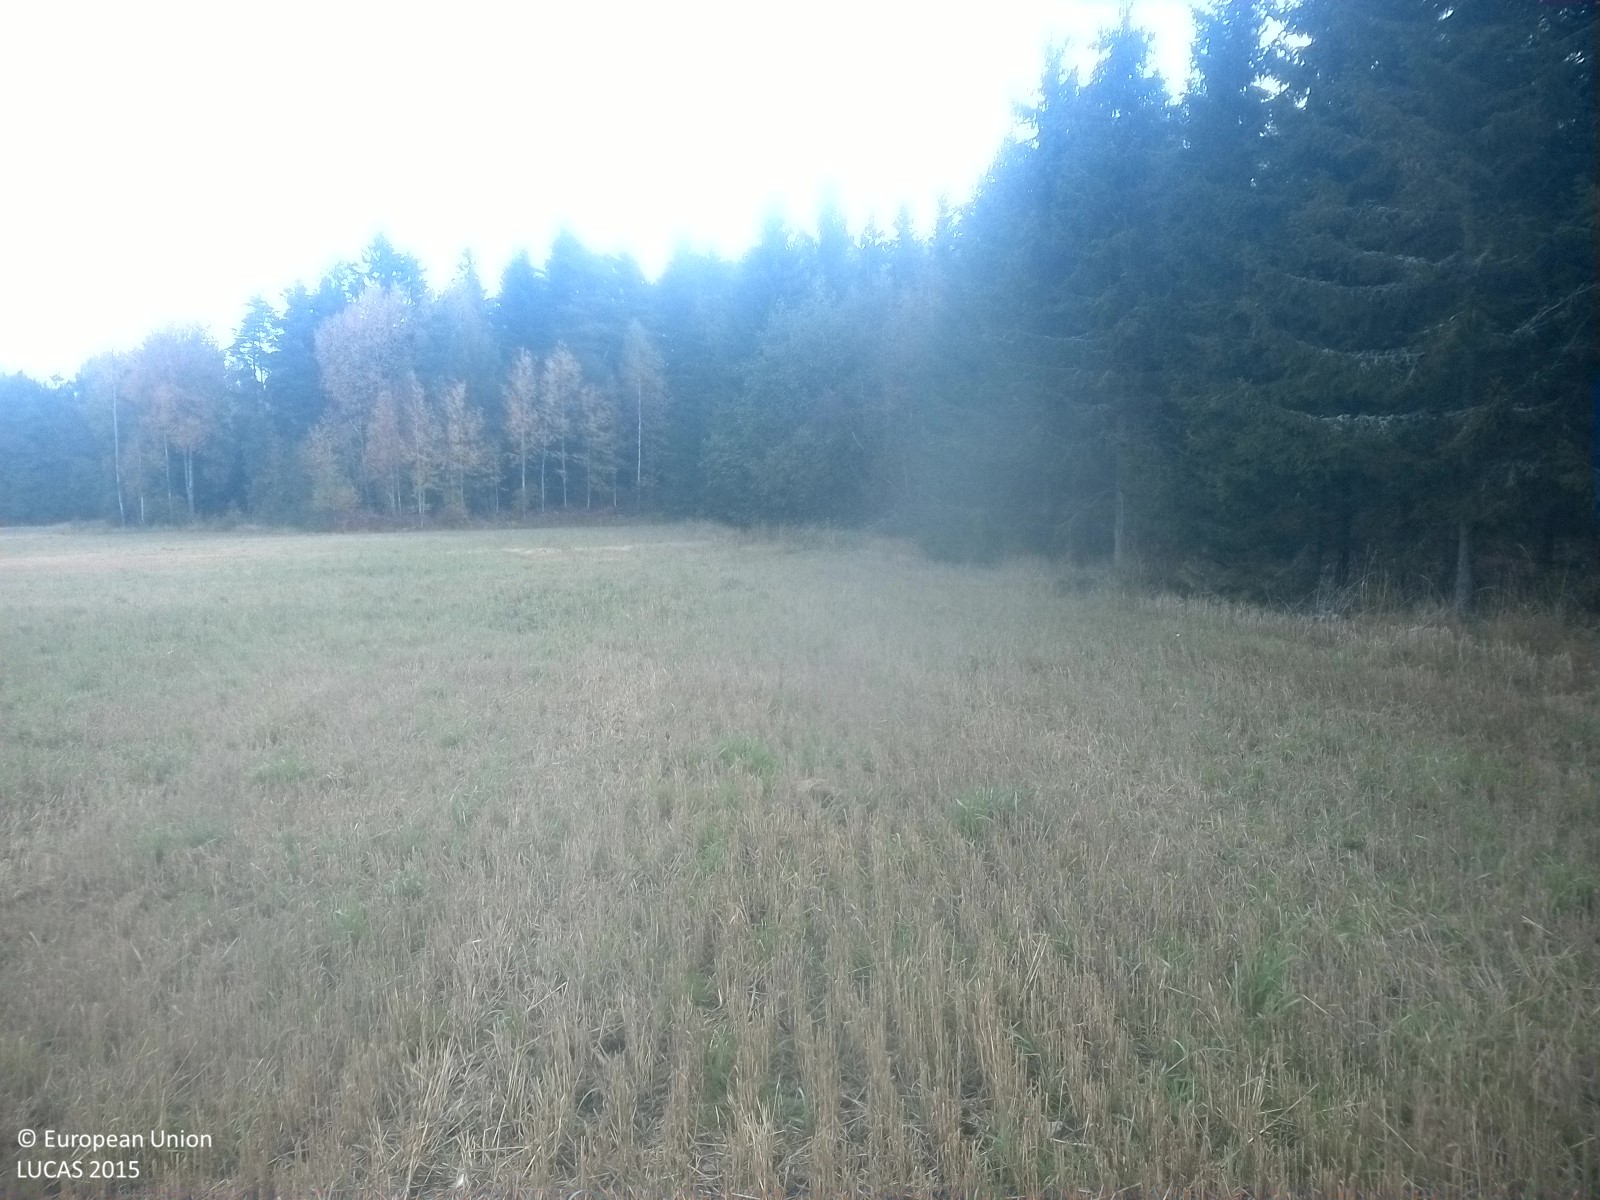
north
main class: Cropland
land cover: Barley
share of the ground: < 10 %
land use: Agriculture (excluding fallow land and kitchen gardens)
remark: Harvested field
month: September
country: SE
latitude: 58.6970
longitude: 16.8124
